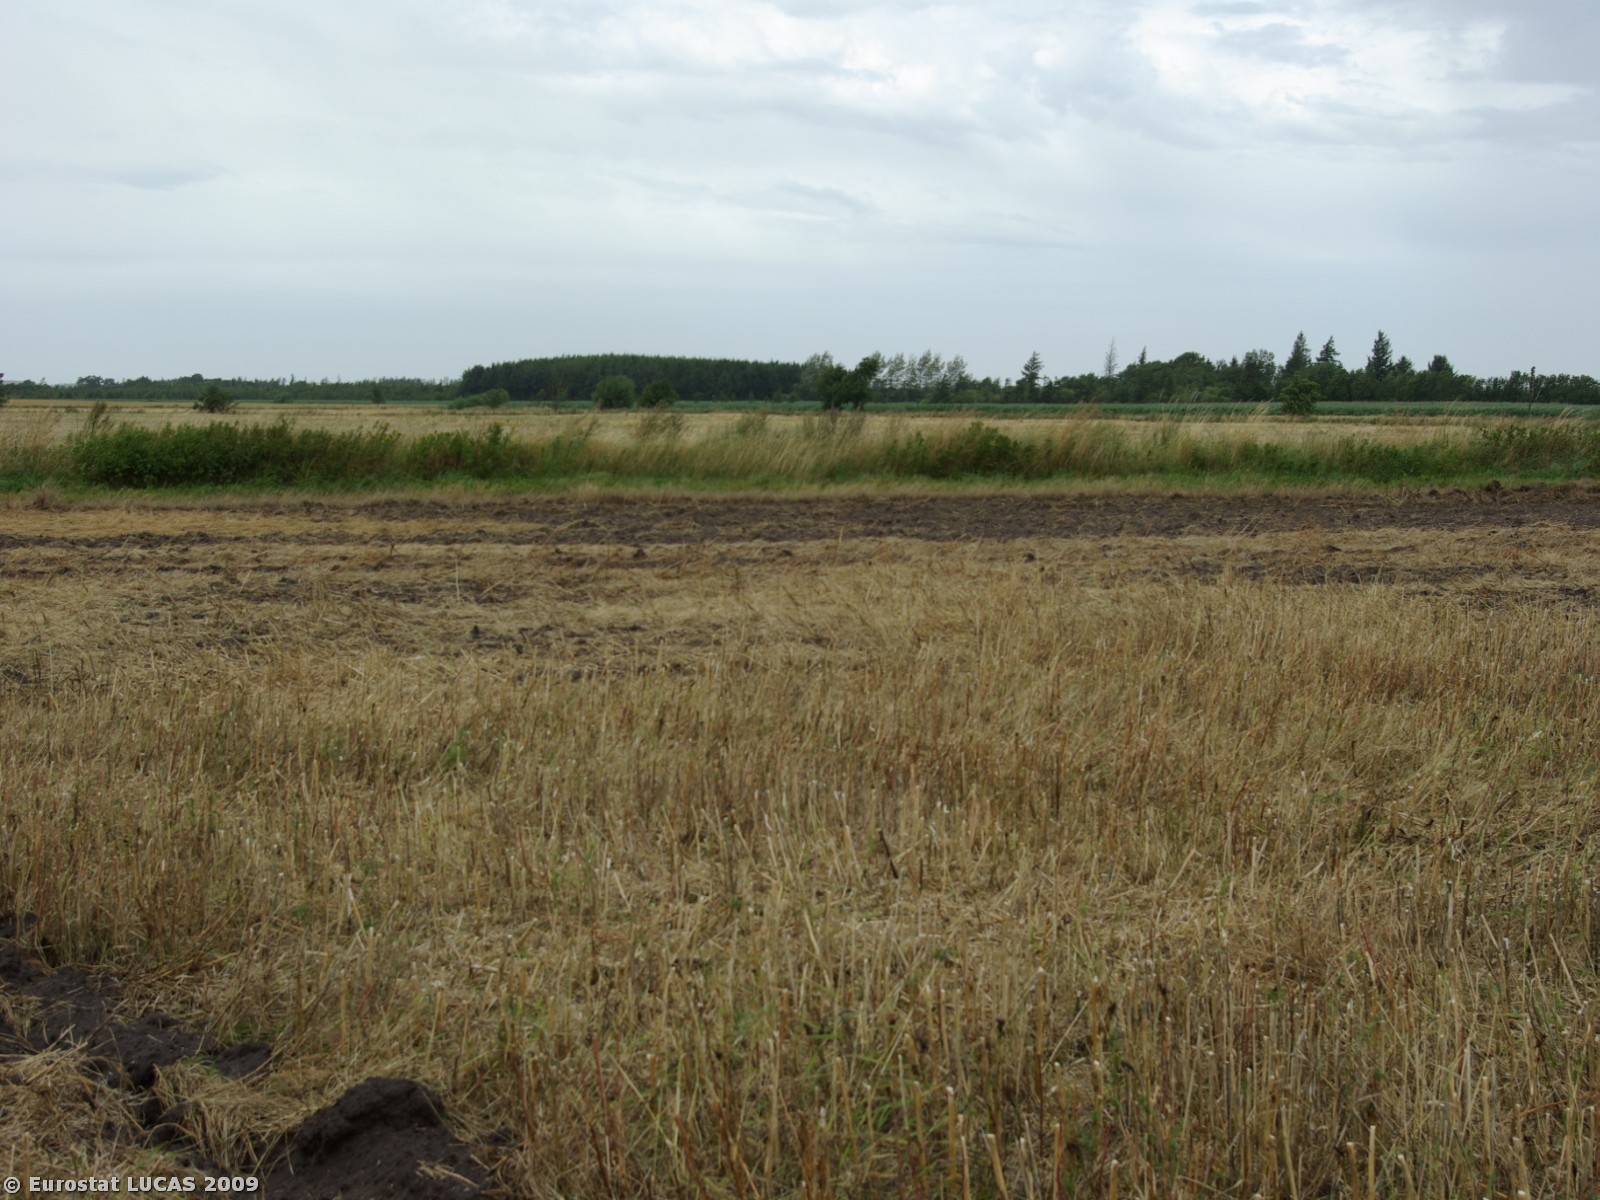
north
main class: Cropland
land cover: Rape and turnip rape
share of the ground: < 10 %
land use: Agriculture (excluding fallow land and kitchen gardens)
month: July
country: DK
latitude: 55.2312
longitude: 9.0103
